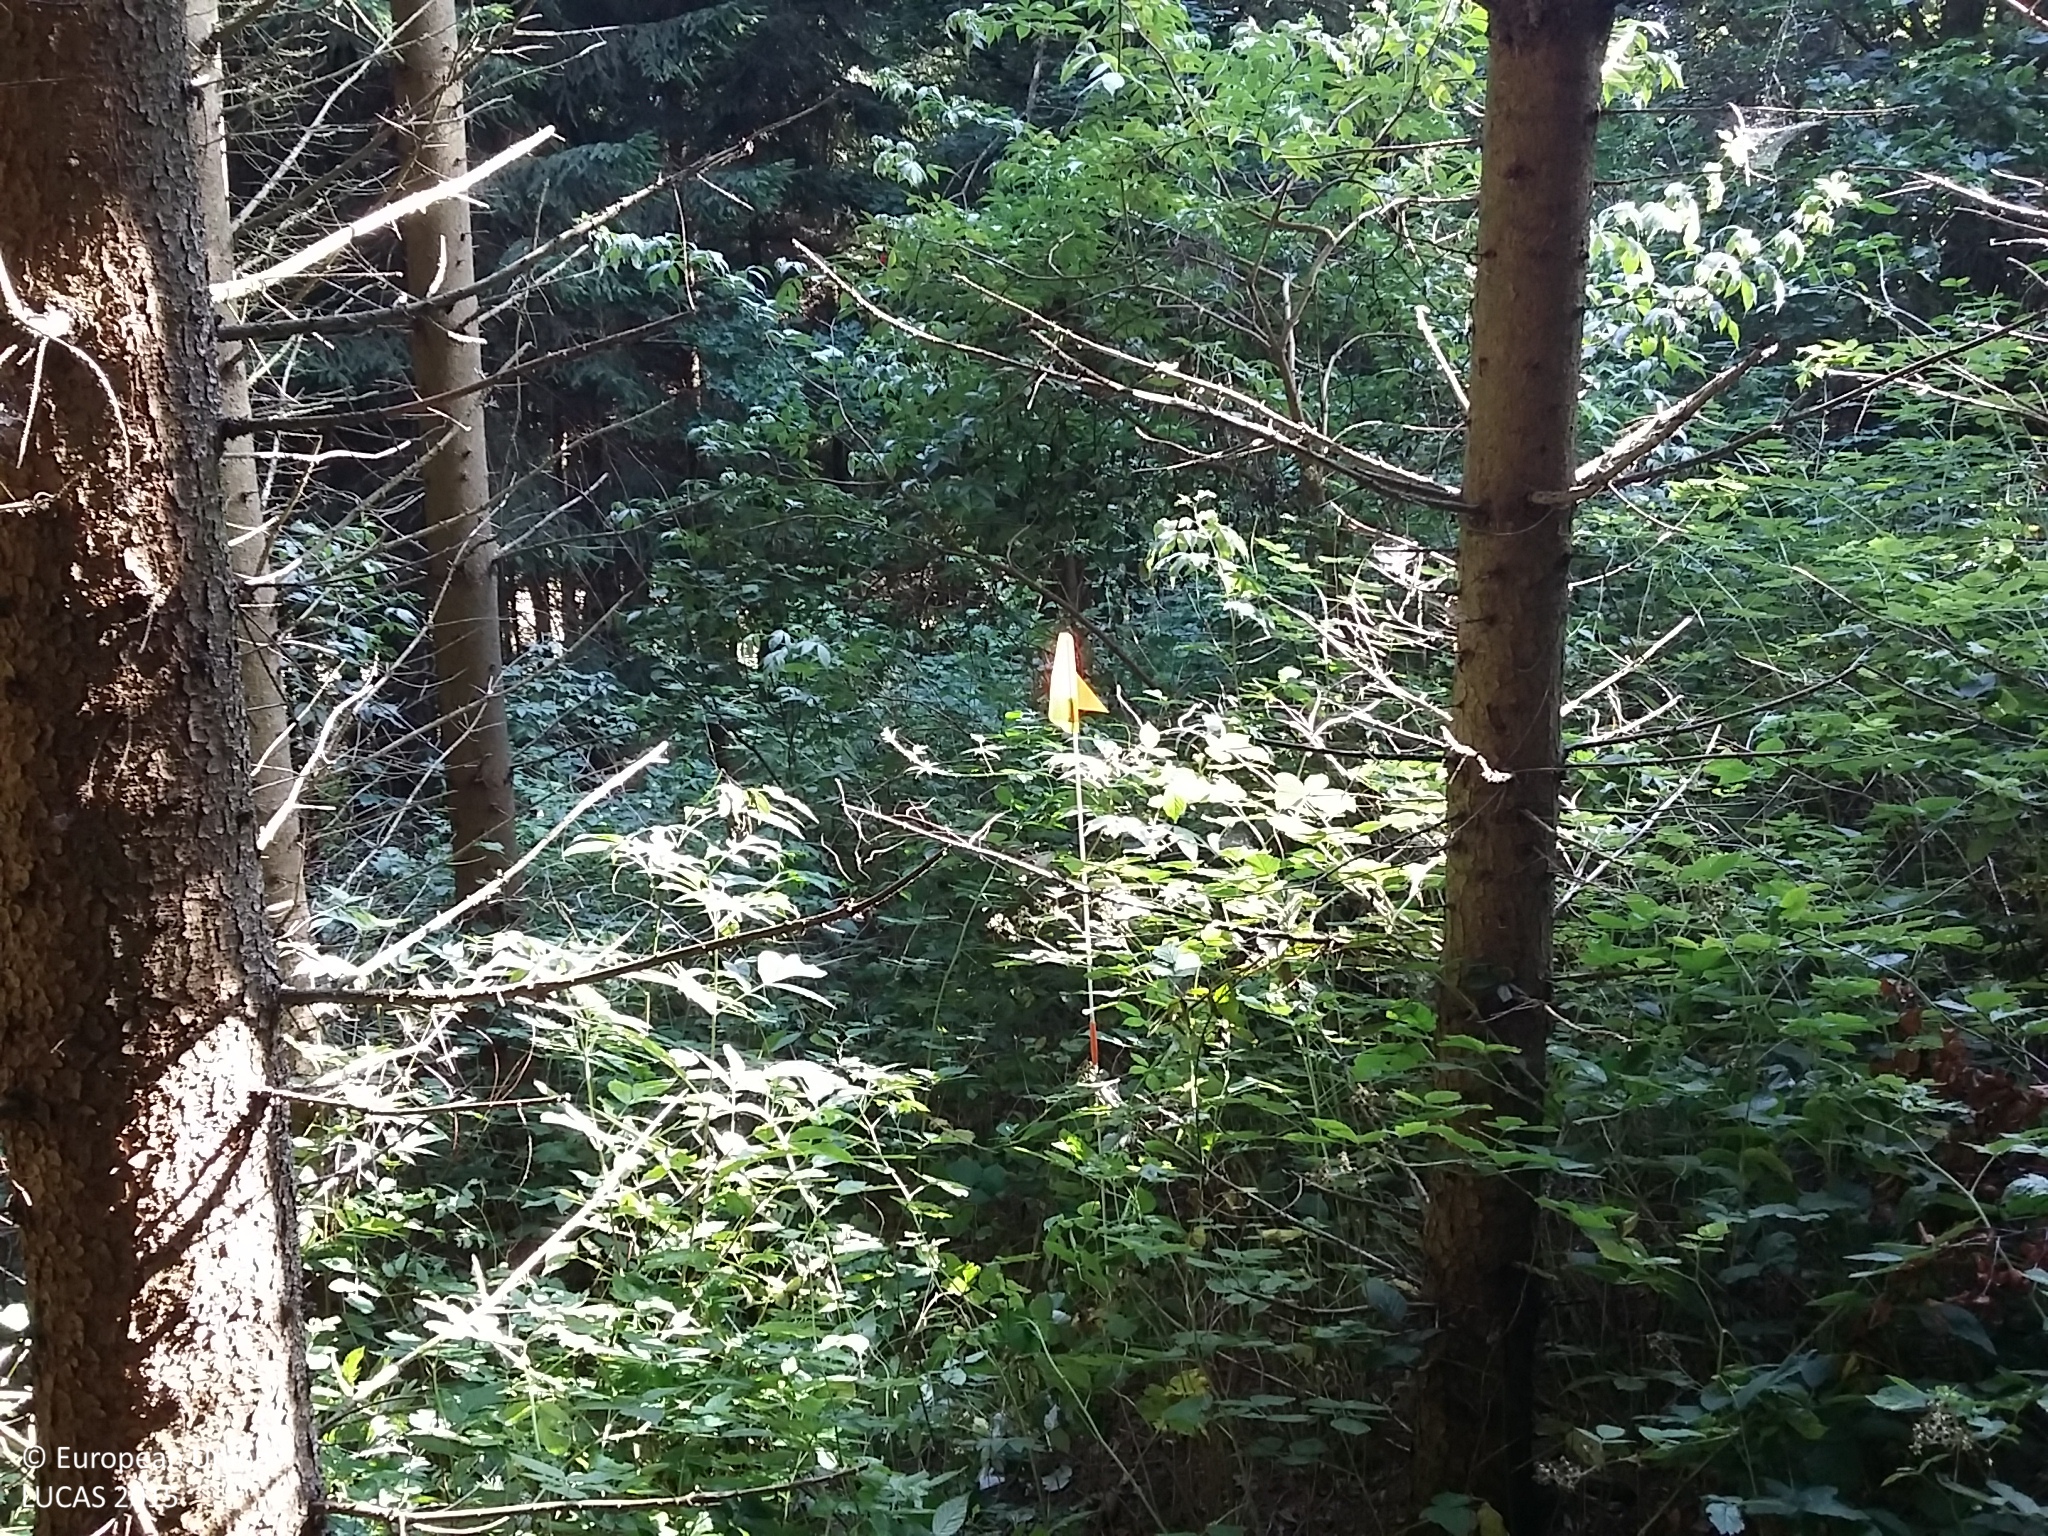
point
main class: Woodland
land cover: Spruce dominated coniferous woodland
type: hemiboreal forest and nemoral coniferous forest and mixed broadleaved-coniferous forest
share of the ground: > 75 %
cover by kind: coniferous forest trees 75 %, broadleaved forest trees 15 %, herbaceous plants 10 %
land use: Forestry
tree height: > 5 m
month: August
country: DK
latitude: 55.1991
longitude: 14.7603
